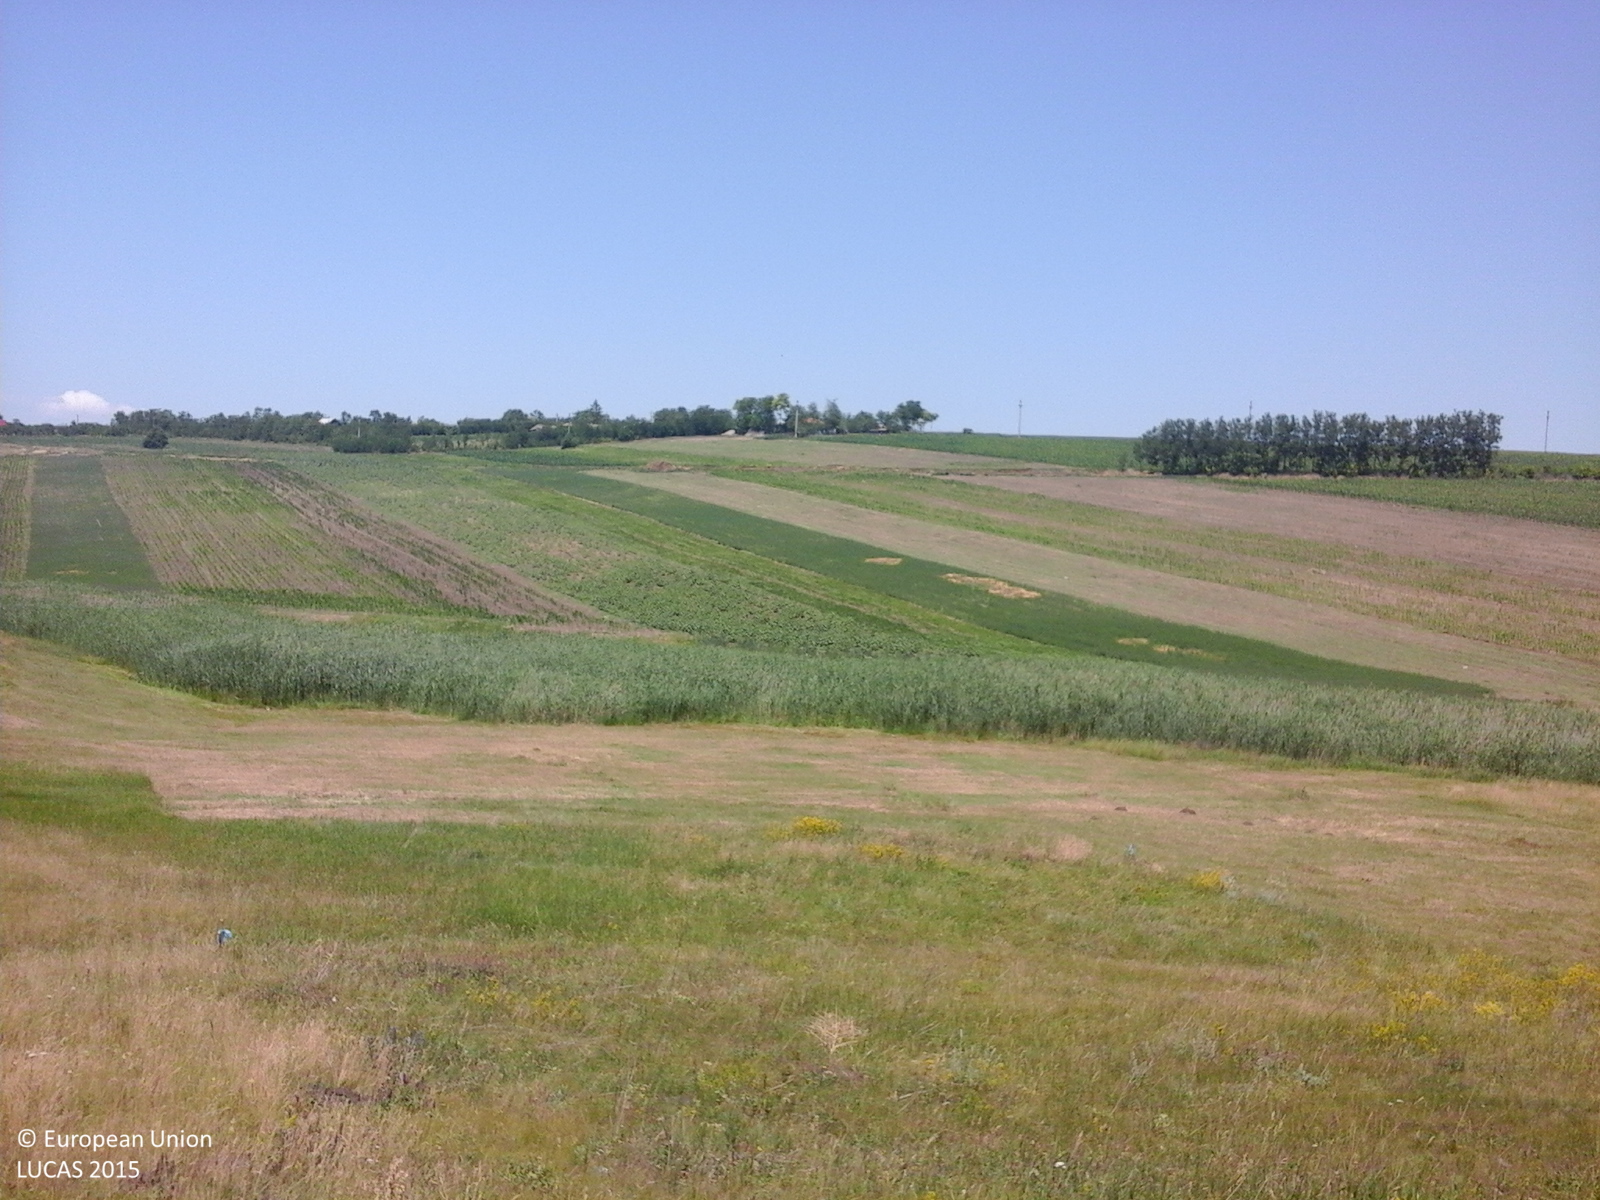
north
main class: Grassland
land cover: Grassland without tree/shrub cover
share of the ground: > 75 %
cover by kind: herbaceous plants 100 %
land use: Agriculture (excluding fallow land and kitchen gardens)
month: June
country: RO
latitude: 47.4461
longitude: 27.2031
